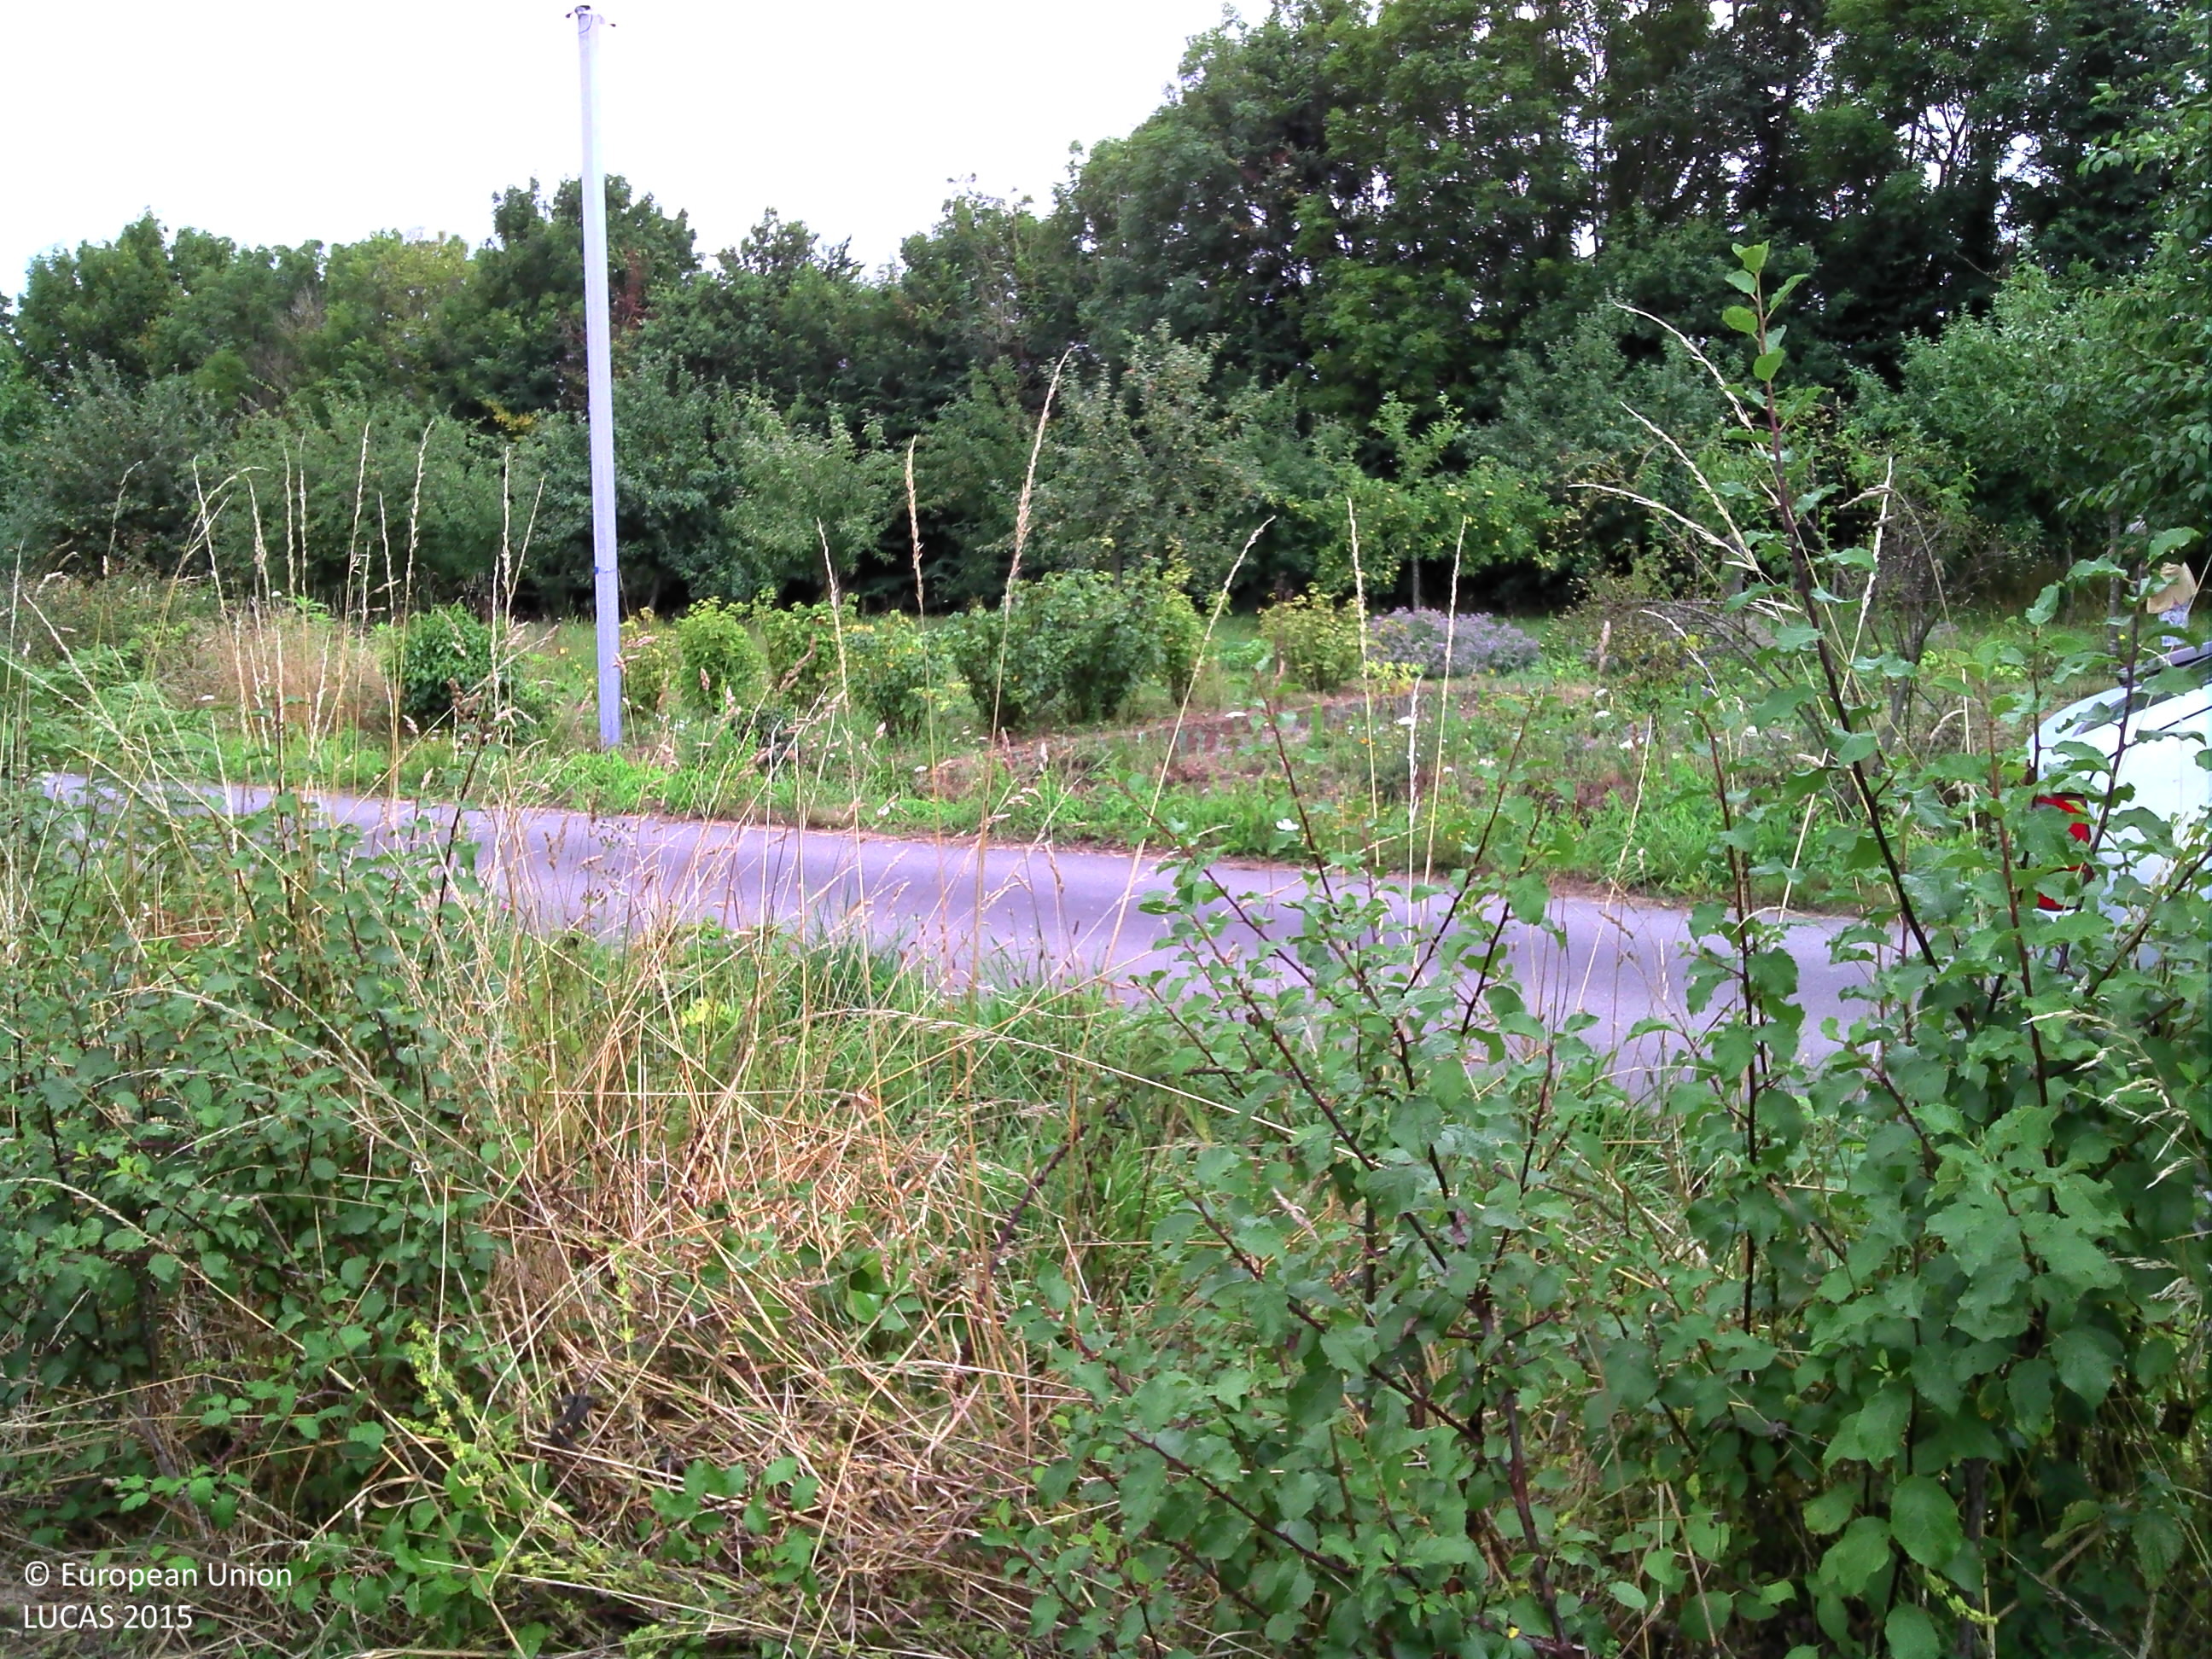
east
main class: Cropland
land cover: Maize
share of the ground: > 75 %
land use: Agriculture (excluding fallow land and kitchen gardens)
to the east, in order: Maize; Broadleaved woodland; Dry pulses
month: July
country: FR
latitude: 47.6543
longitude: -2.9668
